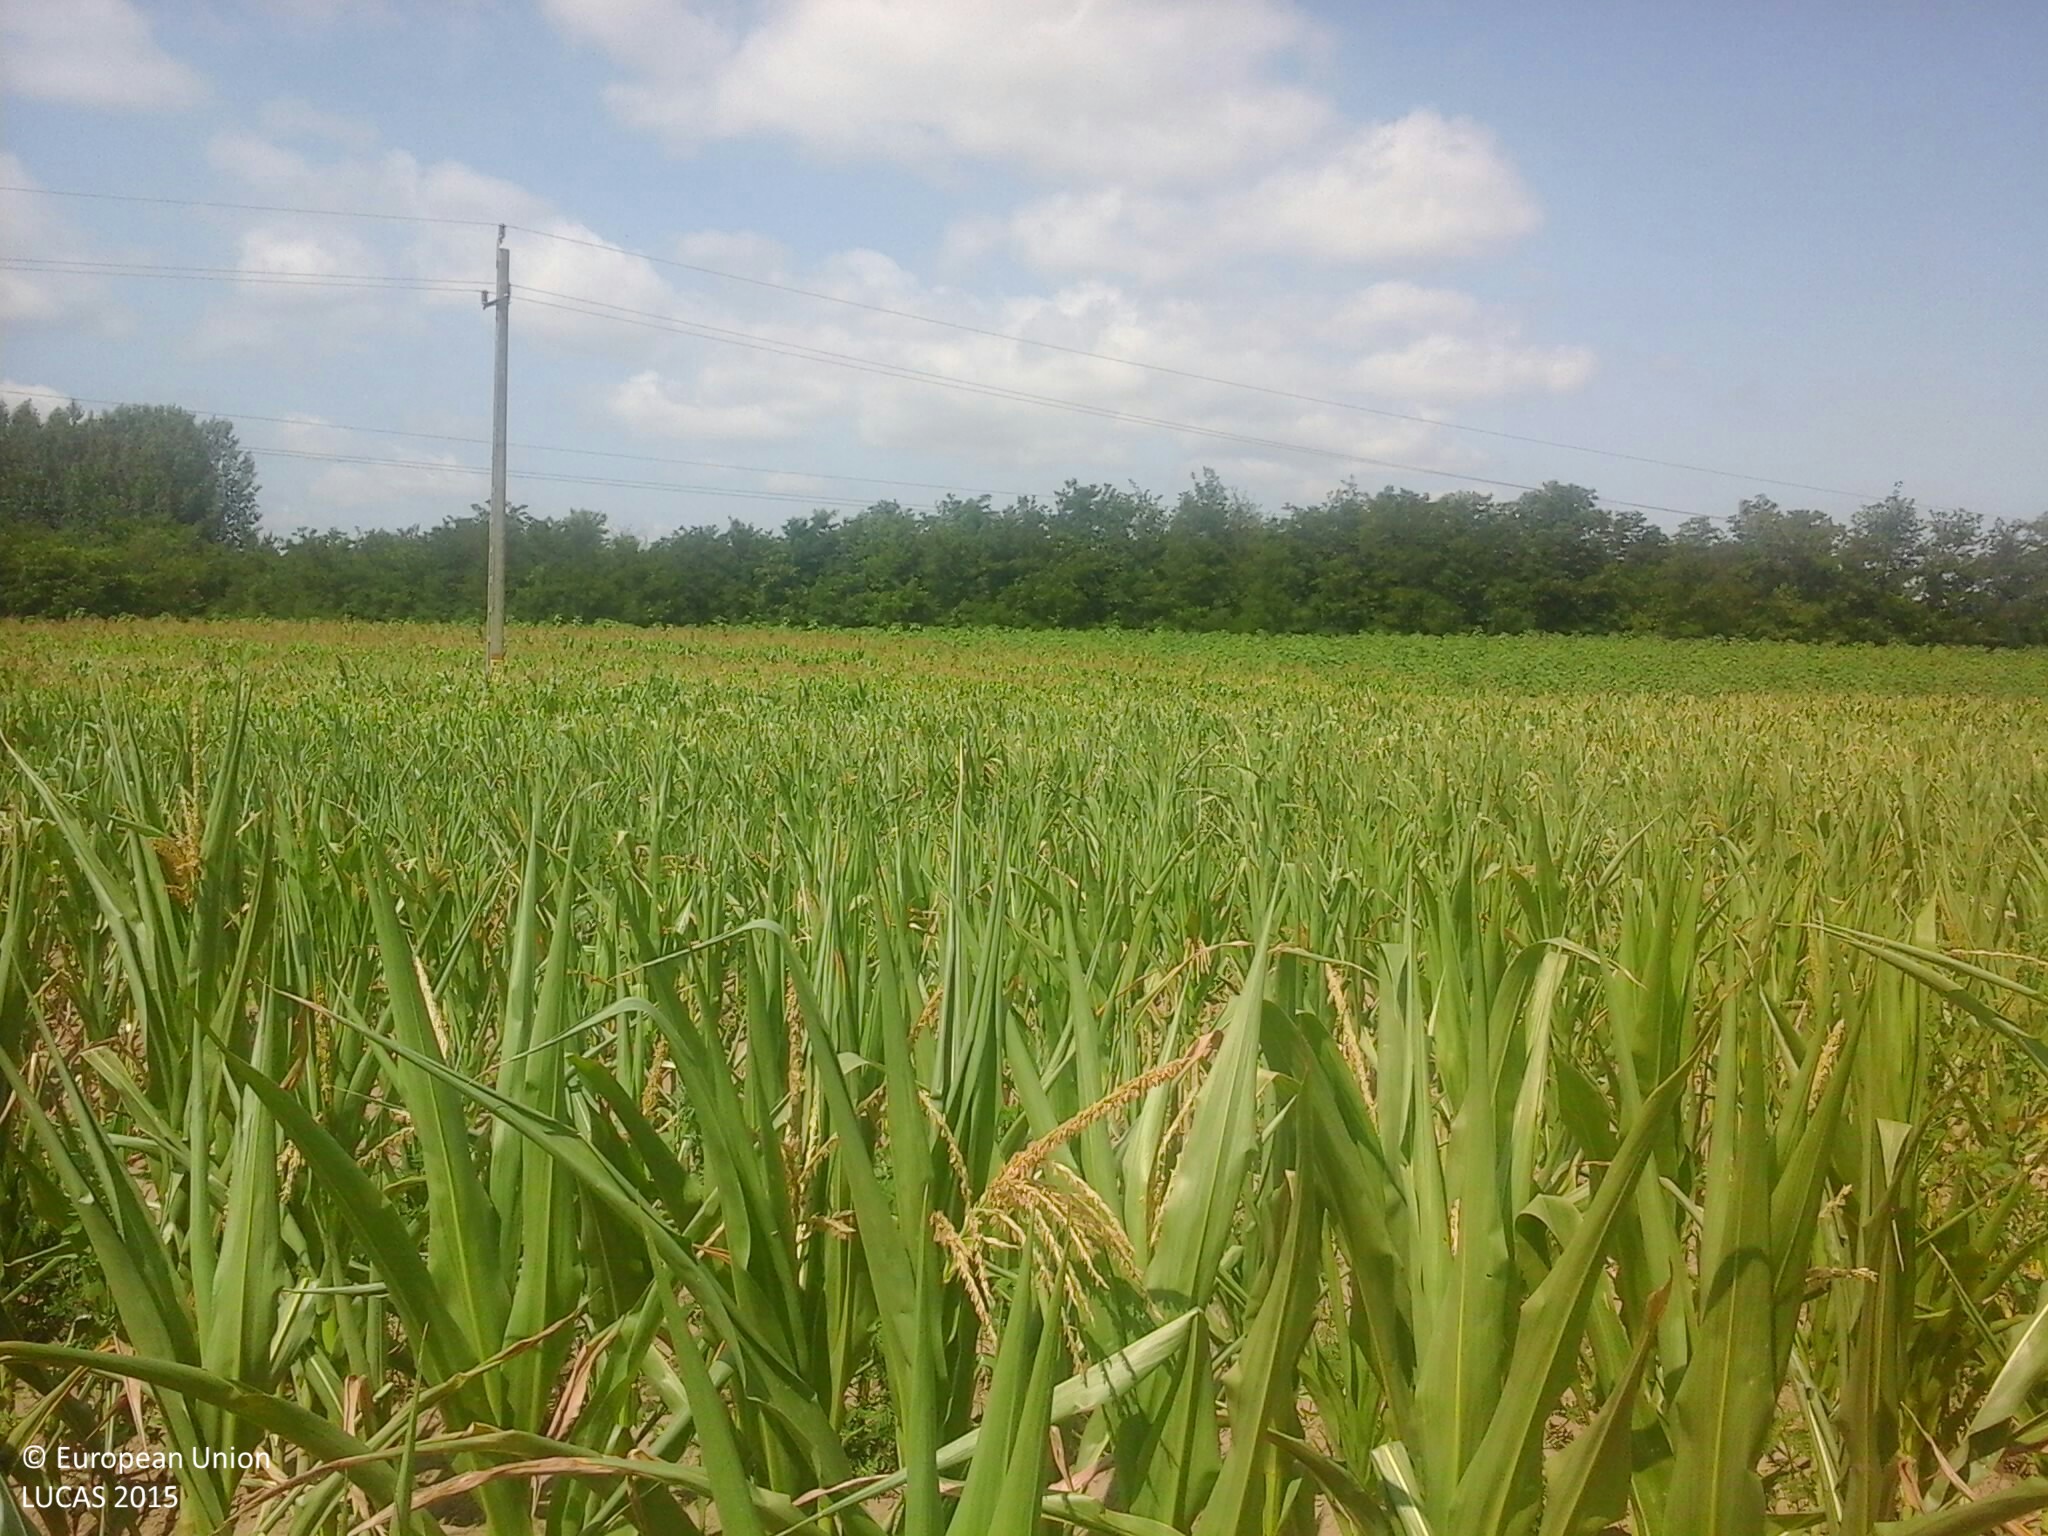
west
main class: Cropland
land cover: Maize
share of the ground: 50 - 75 %
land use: Agriculture (excluding fallow land and kitchen gardens)
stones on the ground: < 10 %
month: July
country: HU
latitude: 47.8580
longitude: 22.1498
